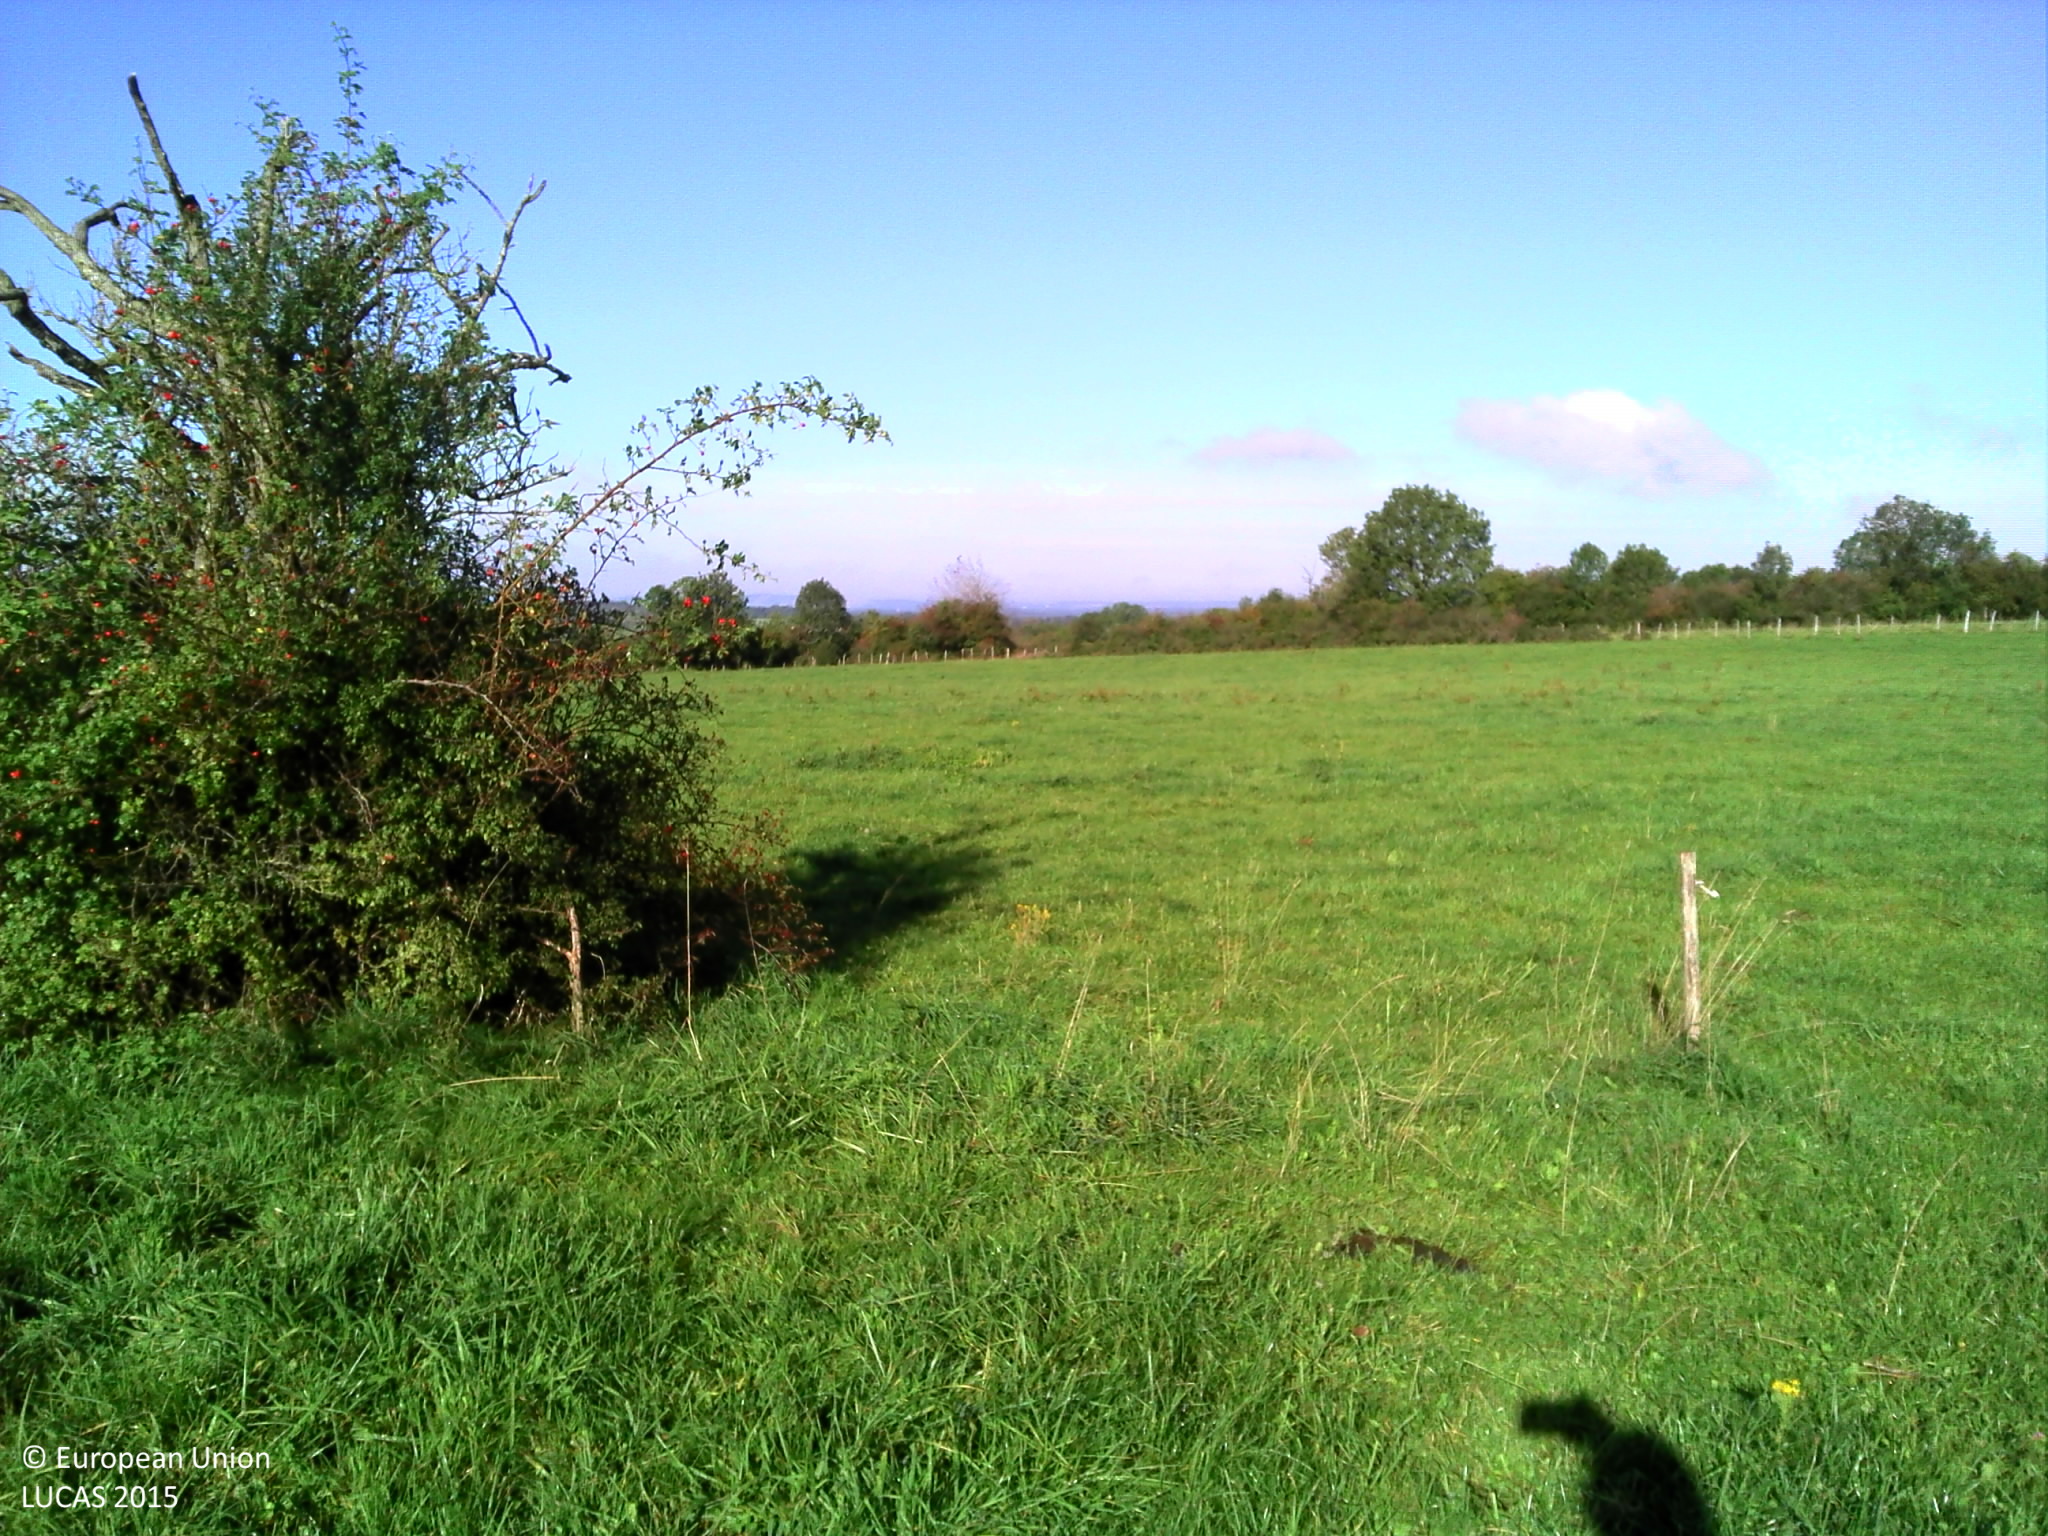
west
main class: Grassland
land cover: Grassland with sparse tree/shrub cover
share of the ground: > 75 %
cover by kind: herbaceous plants 95 %, broadleaved forest trees 5 %
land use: Agriculture (excluding fallow land and kitchen gardens)
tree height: > 5 m
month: September
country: FR
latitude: 47.1182
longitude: 6.3512
